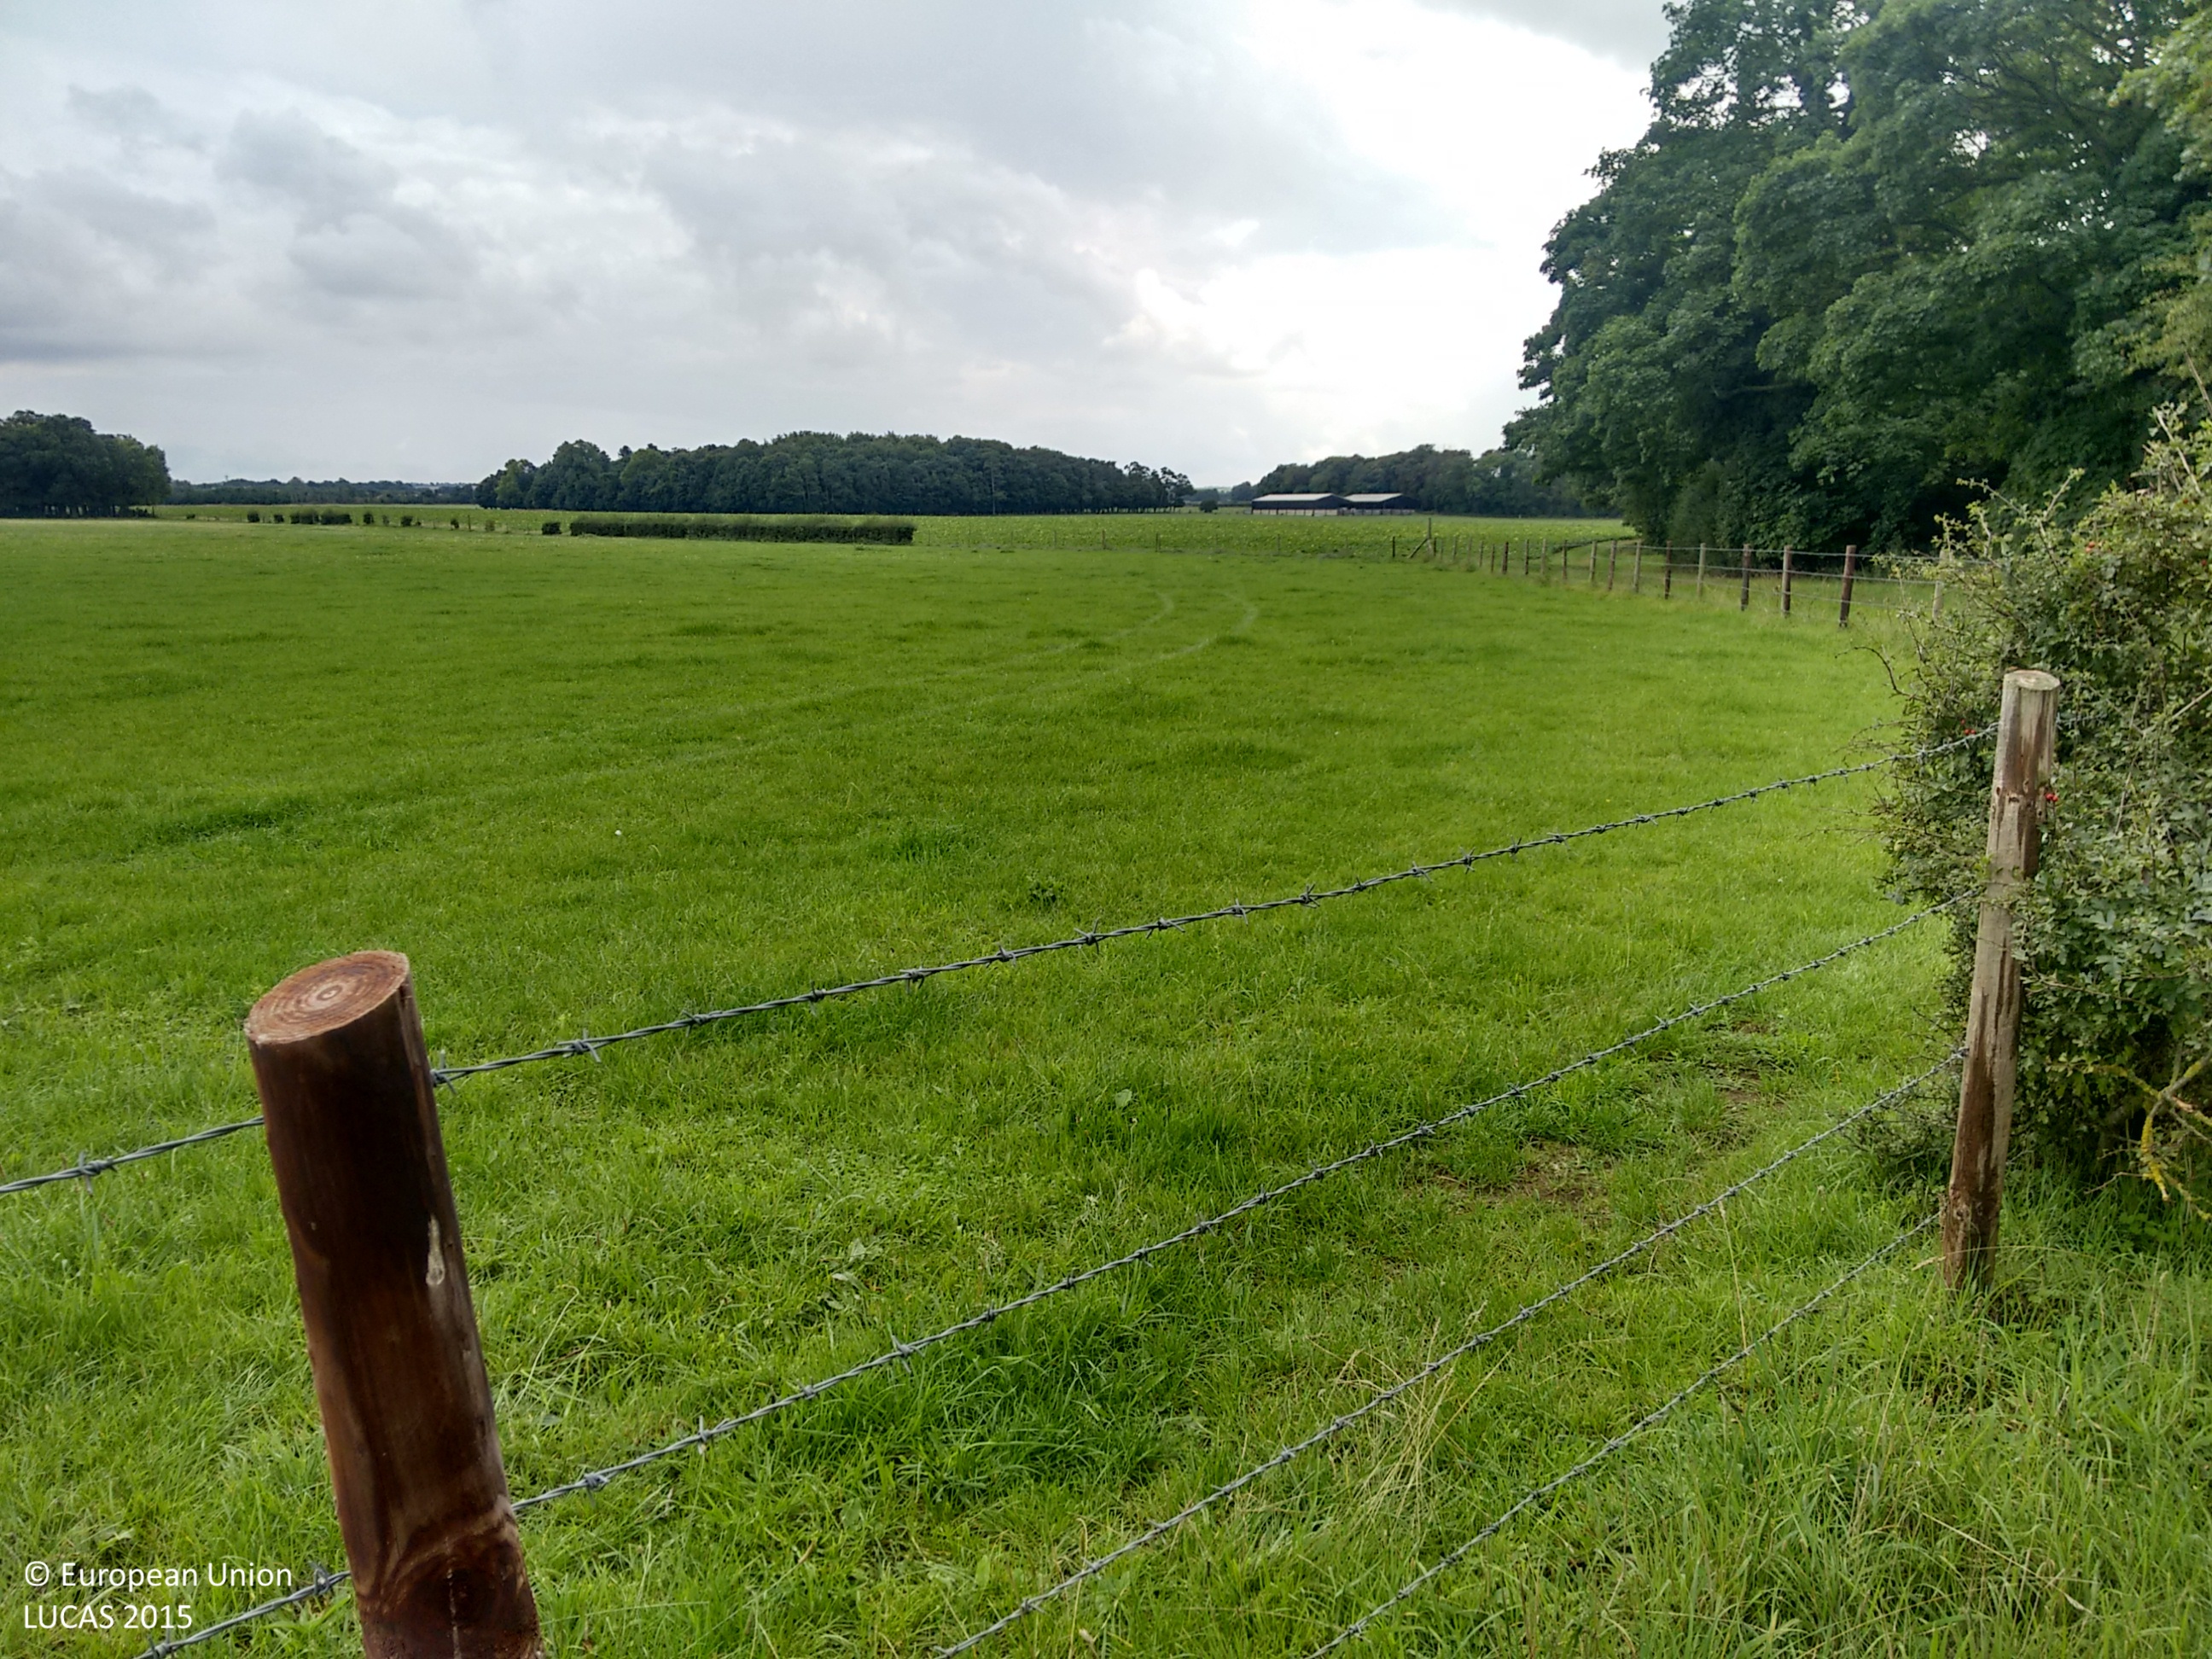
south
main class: Grassland
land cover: Grassland without tree/shrub cover
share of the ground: > 75 %
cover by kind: herbaceous plants 100 %
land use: Agriculture (excluding fallow land and kitchen gardens)
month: September
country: GB
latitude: 52.2999
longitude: 0.4549
